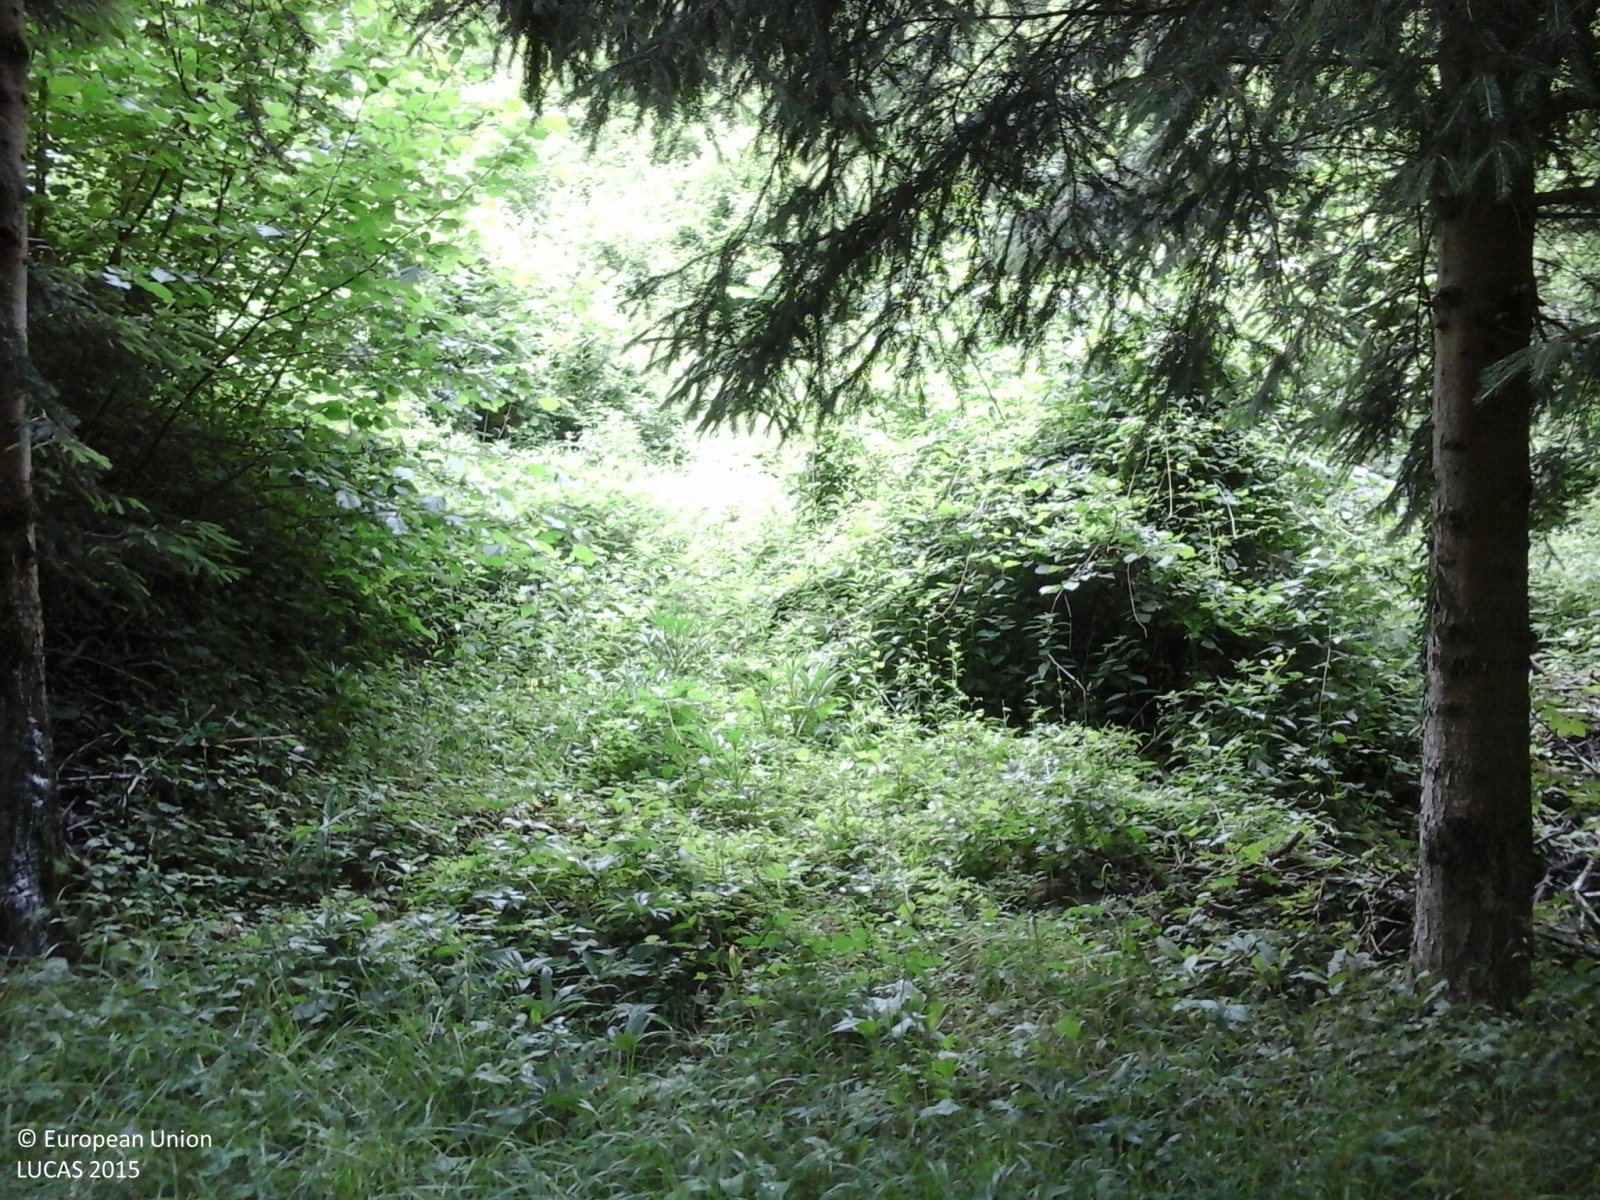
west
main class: Woodland
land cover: Broadleaved woodland
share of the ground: > 75 %
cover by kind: broadleaved forest trees 80 %, coniferous forest trees 20 %
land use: Forestry
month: June
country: IT
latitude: 44.5662
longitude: 9.6105
